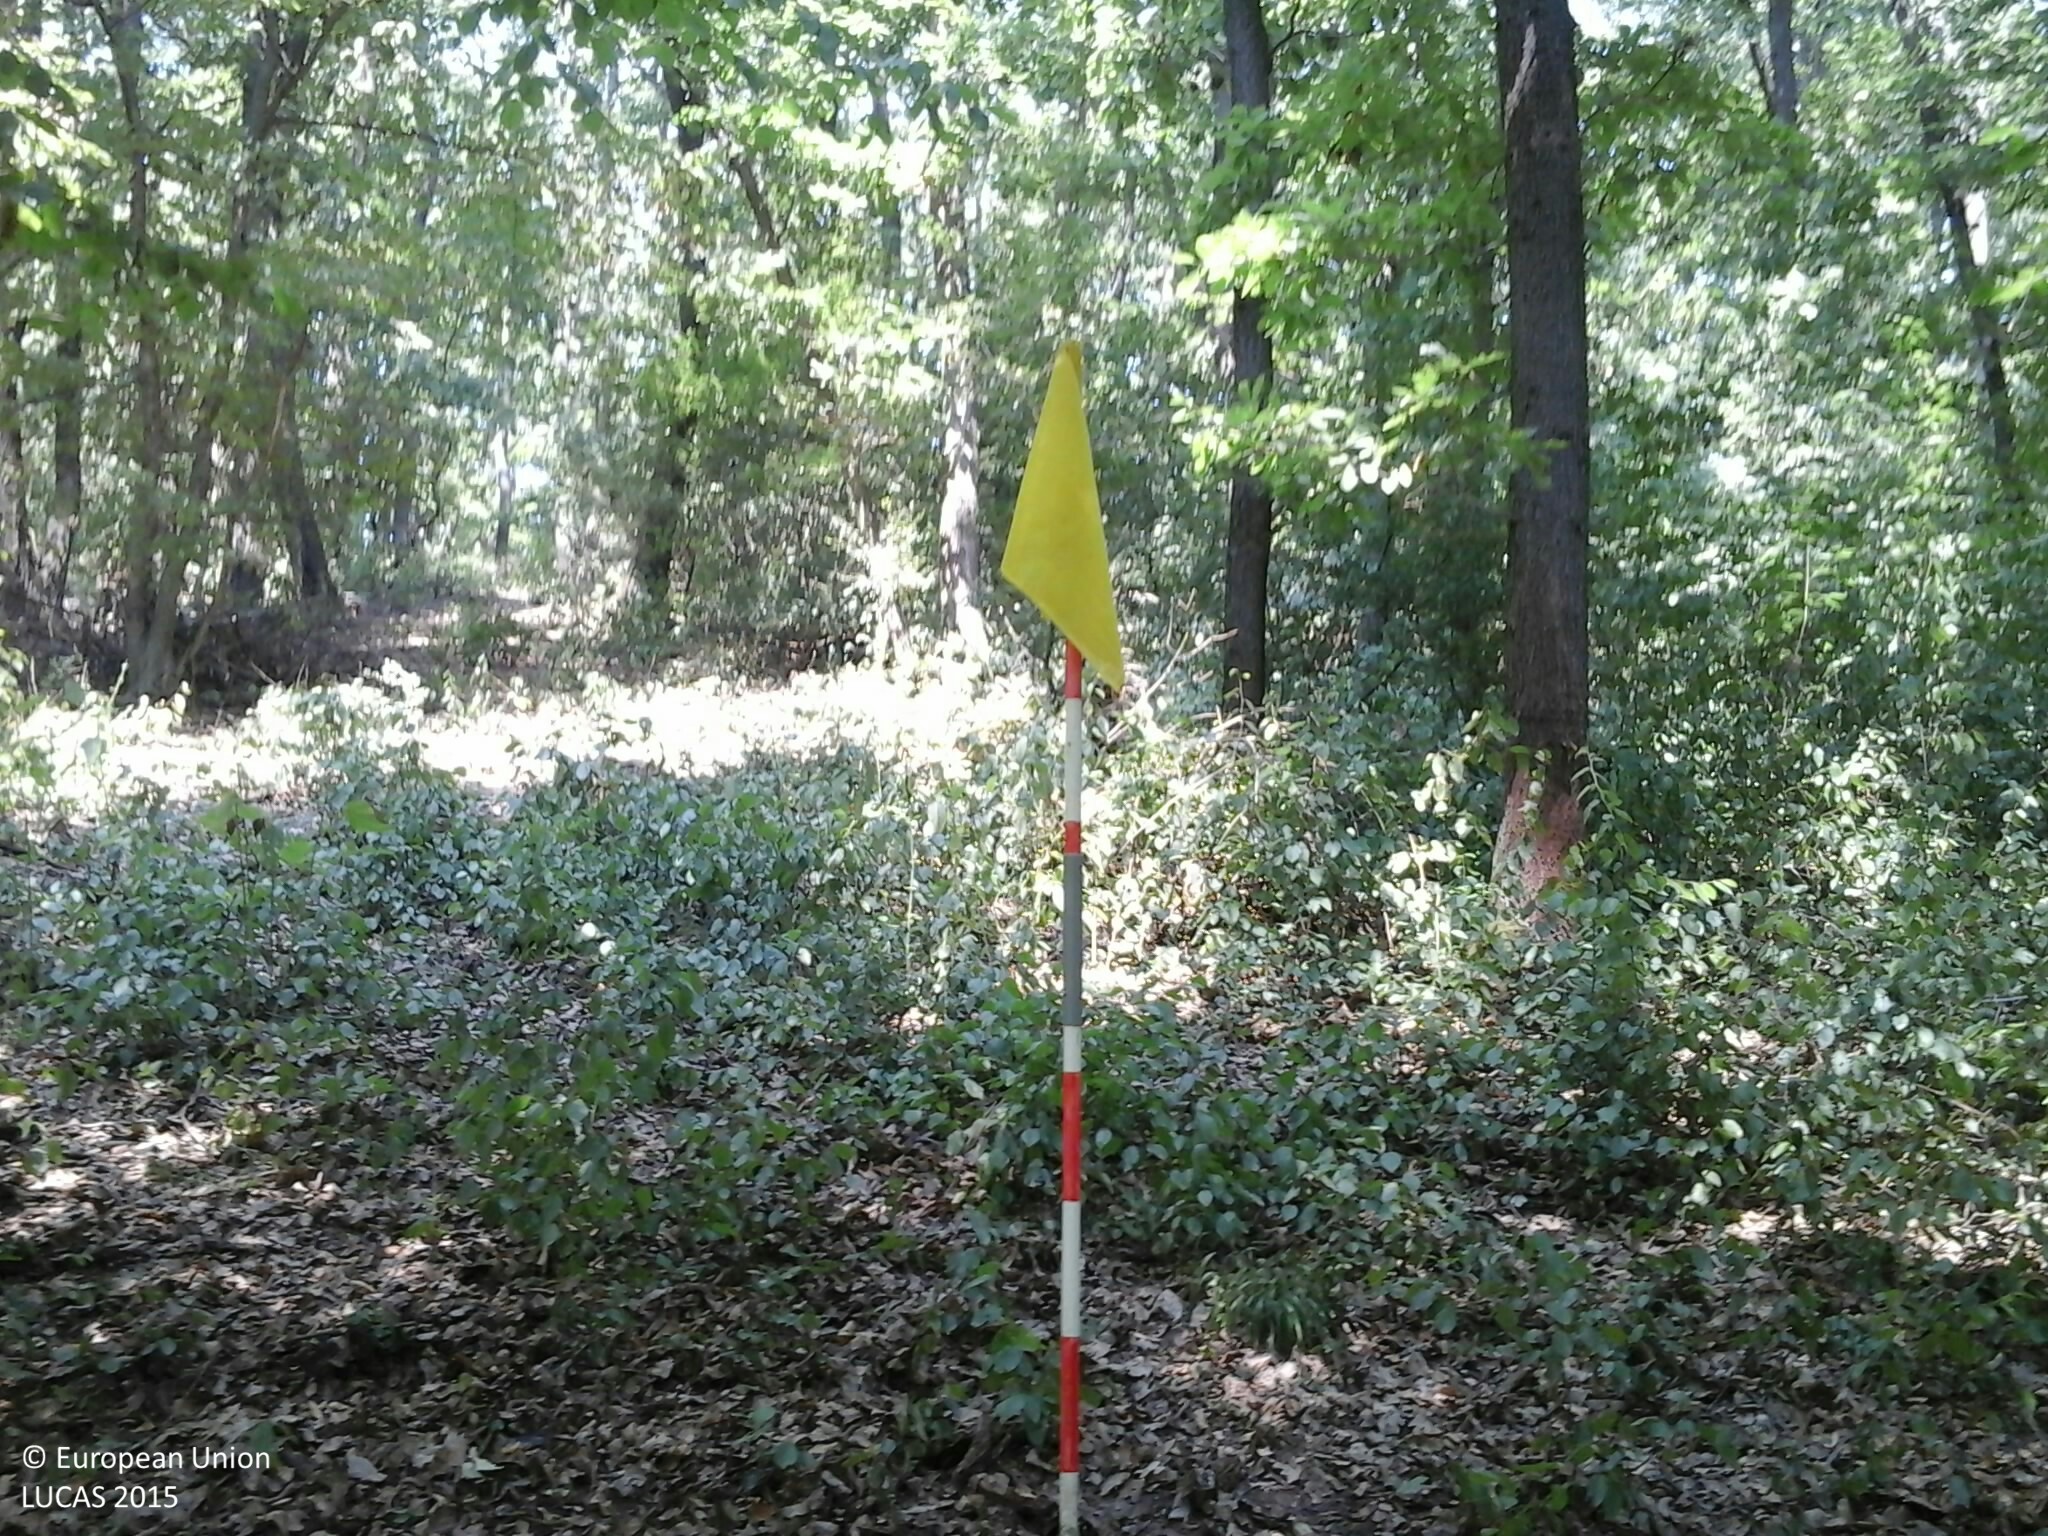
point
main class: Woodland
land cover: Broadleaved woodland
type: mesophytic deciduous forest
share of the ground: > 75 %
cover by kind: broadleaved forest trees 100 %
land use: Forestry
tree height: > 5 m
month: August
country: HU
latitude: 48.3208
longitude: 20.4860
